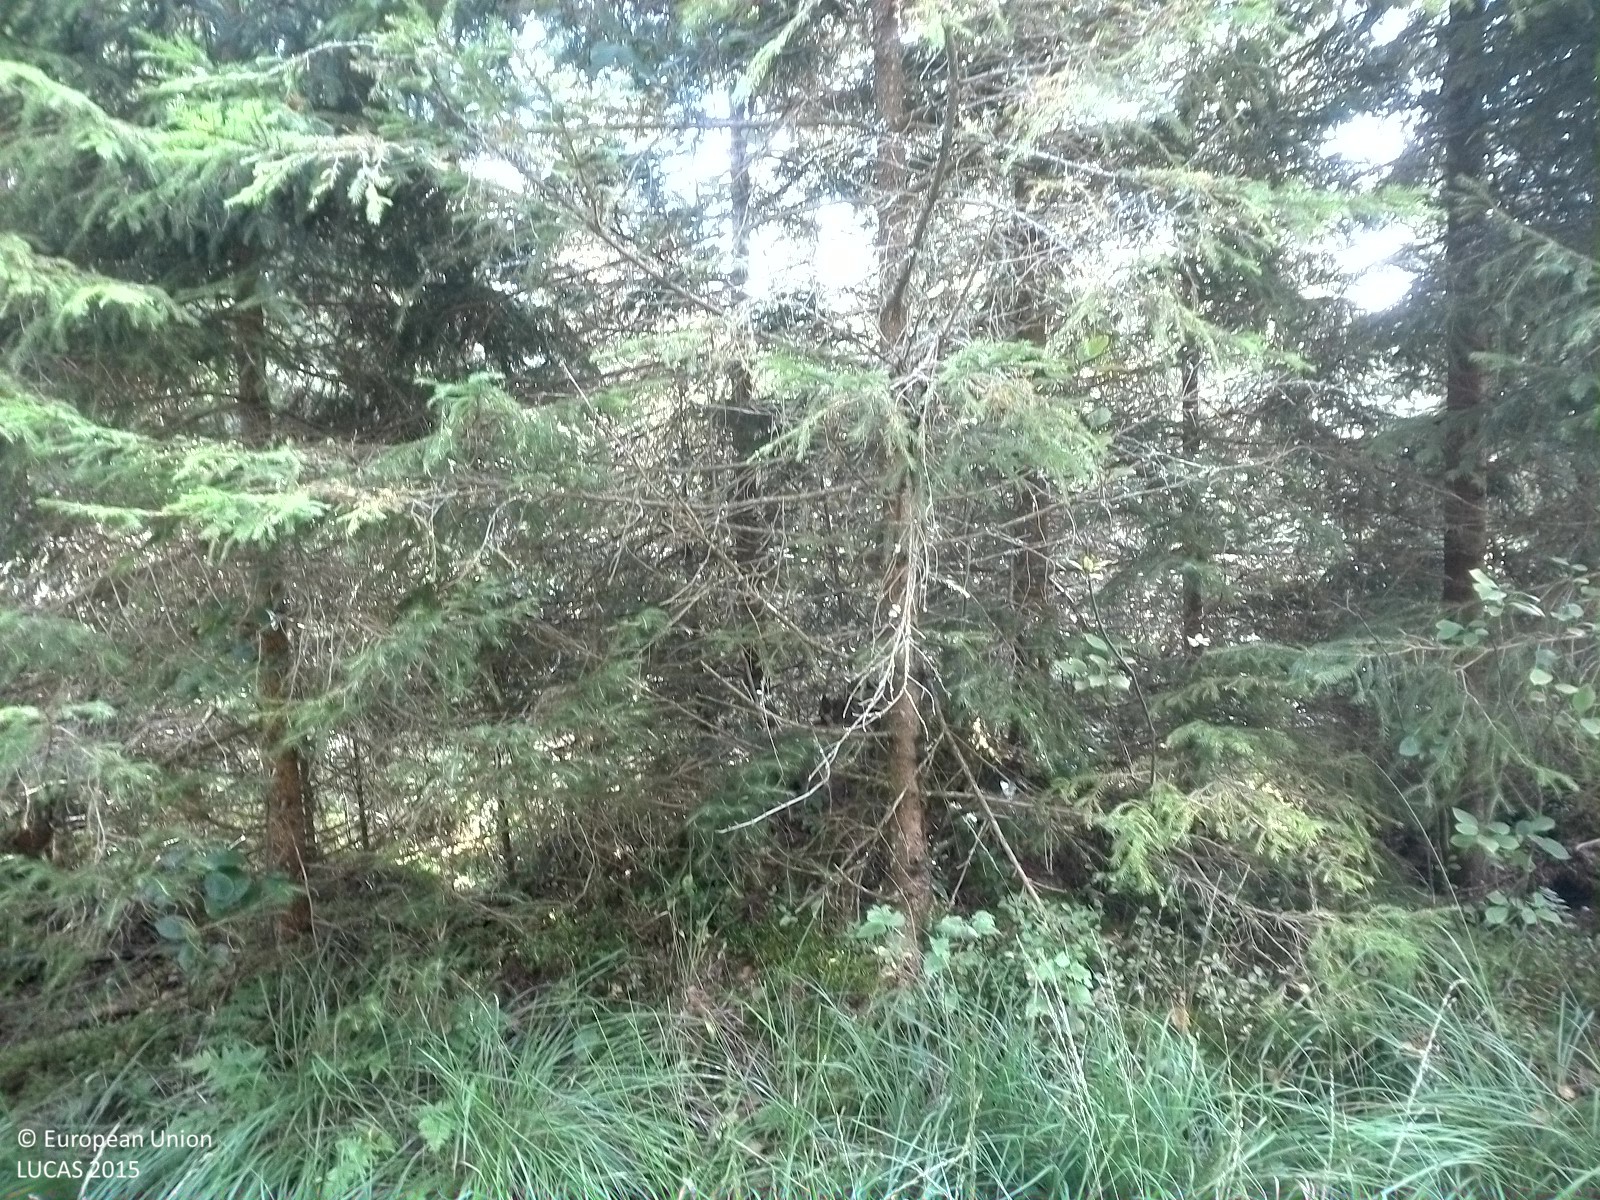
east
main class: Grassland
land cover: Grassland without tree/shrub cover
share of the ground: > 75 %
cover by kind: herbaceous plants 95 %, unconsolidated bare surface 5 %
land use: Amenities, museums, leisure
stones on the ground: < 10 %
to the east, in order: Grassland without tree/shrub cover; Spruce dominated mixed woodland; Tracks; Spruce dominated mixed woodland; Tracks; Spruce dominated mixed woodland
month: August
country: SE
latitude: 59.0966
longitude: 15.5610
